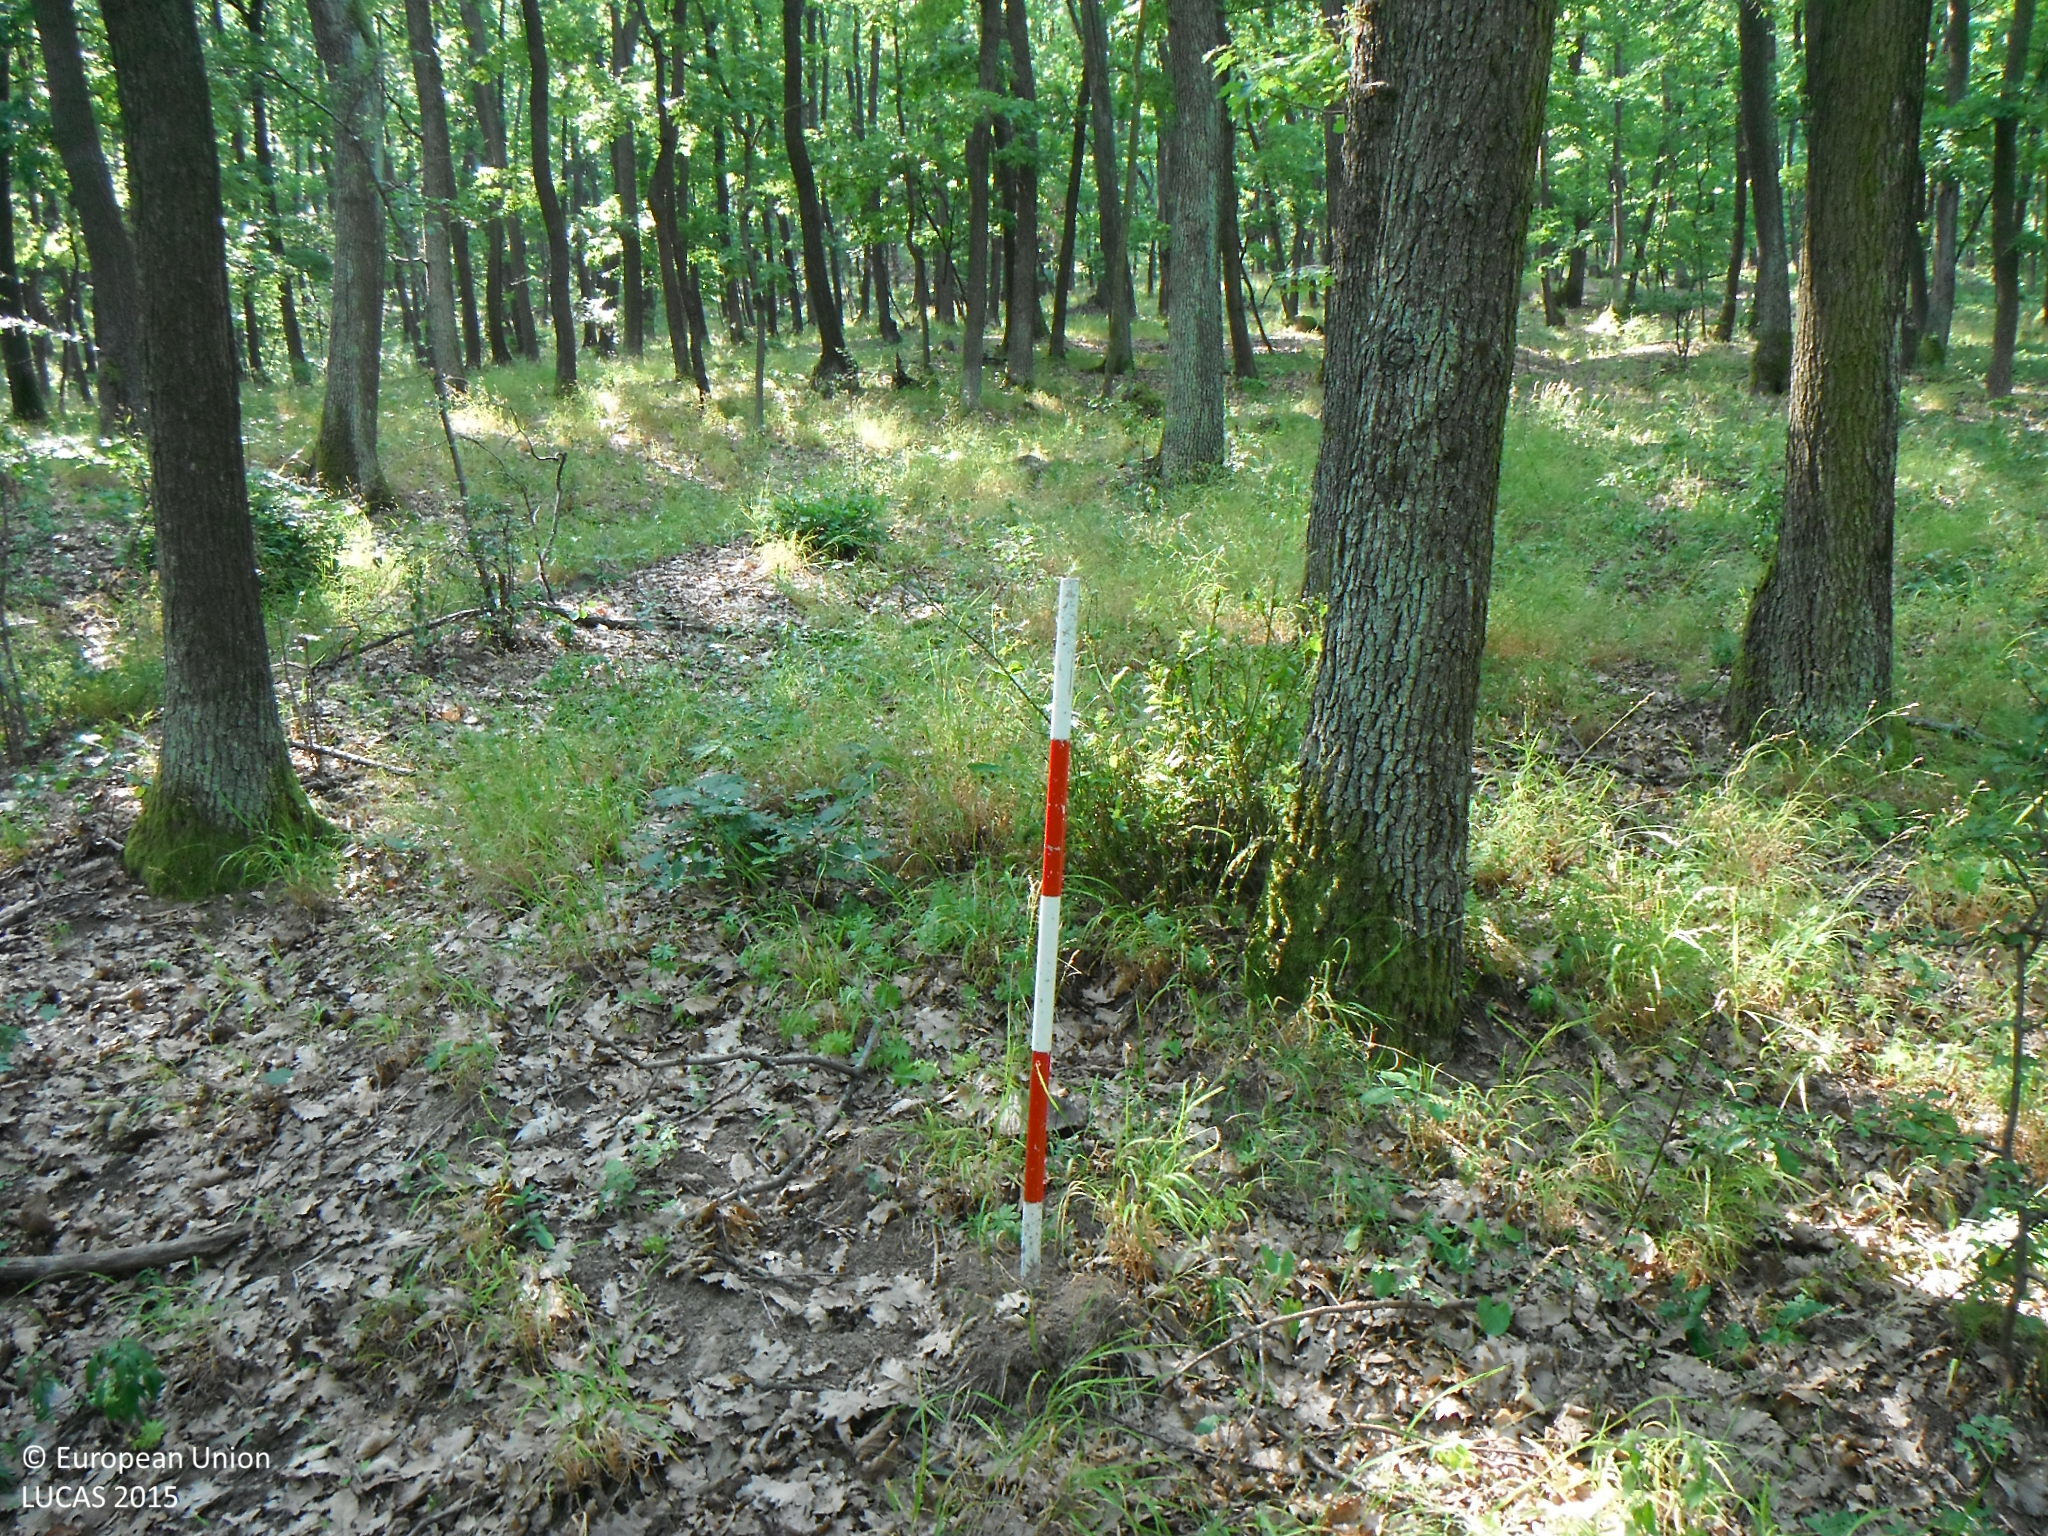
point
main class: Woodland
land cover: Broadleaved woodland
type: acidophilous oak and oak-birch forest
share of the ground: > 75 %
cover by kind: broadleaved forest trees 85 %, herbaceous plants 10 %, shrubs 5 %
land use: Forestry
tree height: > 5 m
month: July
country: SK
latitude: 48.1504
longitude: 19.1477
